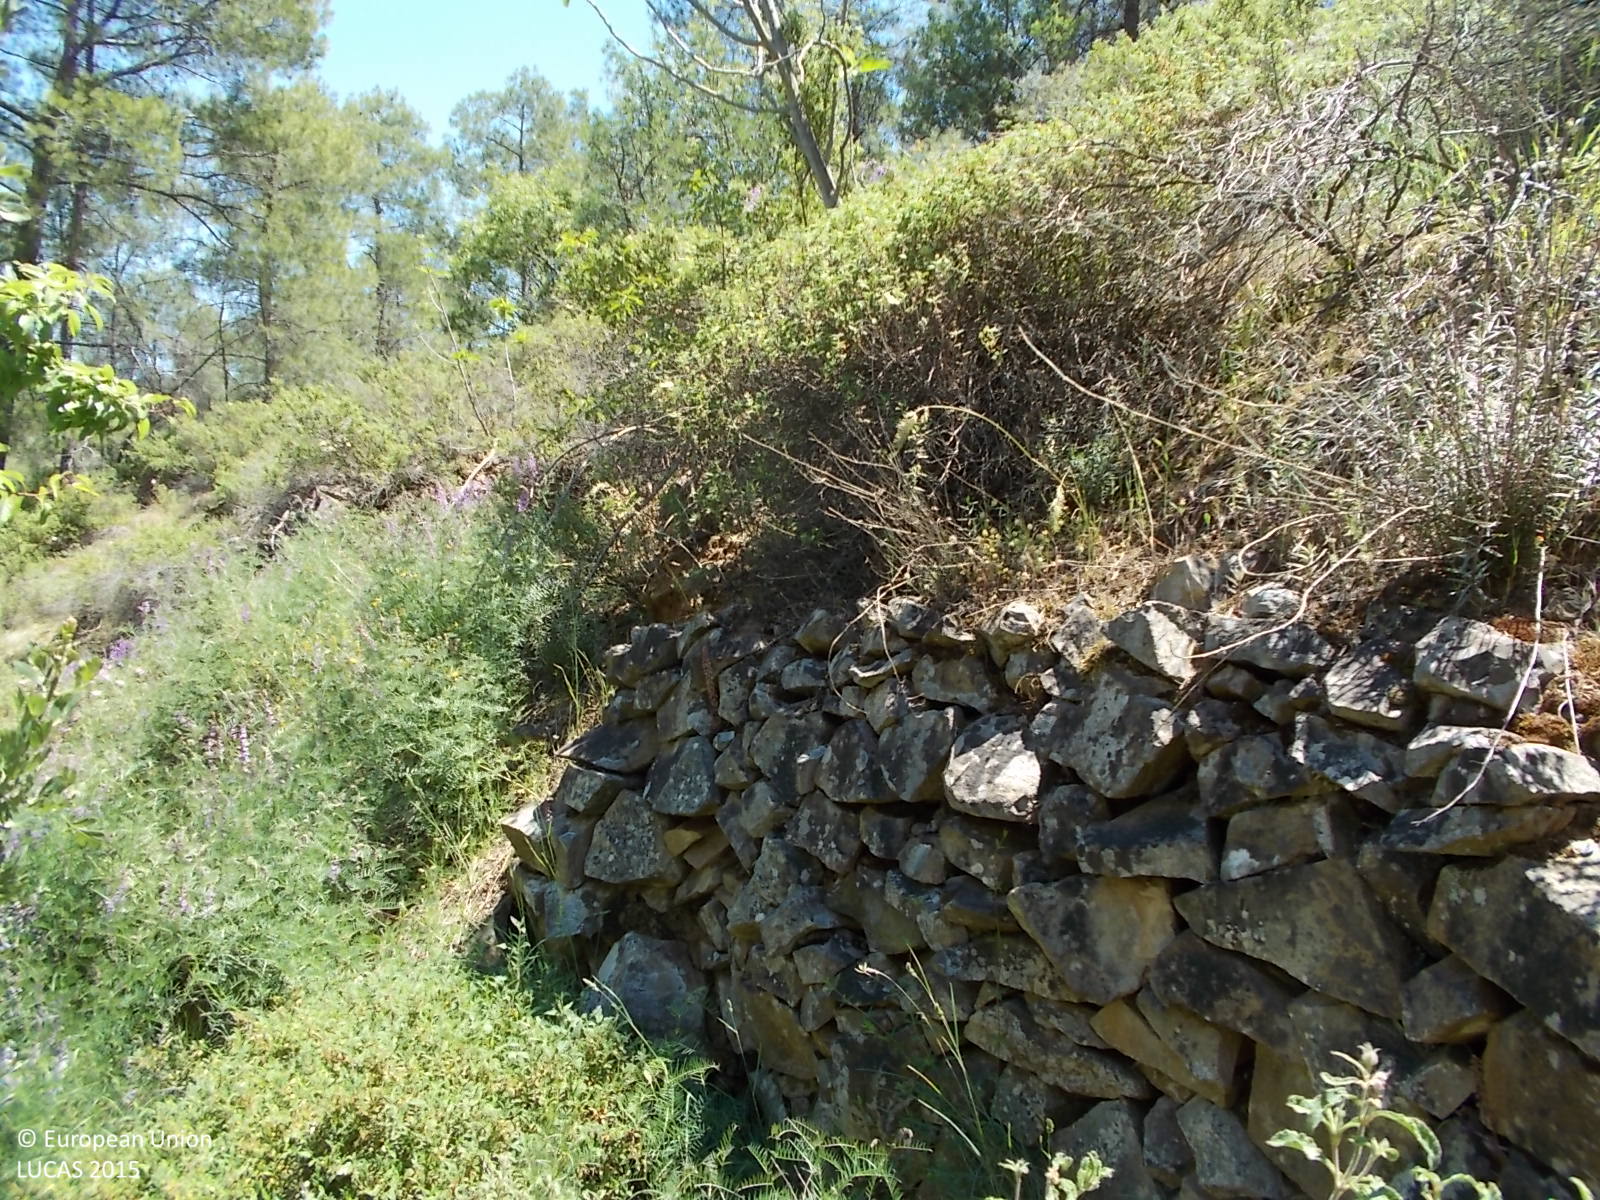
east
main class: Shrubland
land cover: Shrubland with sparse tree cover
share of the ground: > 75 %
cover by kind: shrubs 90 %, broadleaved forest trees 5 %, unconsolidated bare surface 5 %
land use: Semi-natural and natural areas not in use
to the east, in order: Shrubland with sparse tree cover; Dry stone walls; Shrubland with sparse tree cover; Pine dominated coniferous woodland; Shrubland with sparse tree cover; Dry stone walls; Tracks; Olive groves; Tracks; Electric lines; Olive groves; Electric lines; Olive groves; Nuts trees; Tracks; Grassland with sparse tree/shrub cover; Electric lines; Grassland with sparse tree/shrub cover
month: May
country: CY
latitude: 34.9633
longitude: 33.1444
